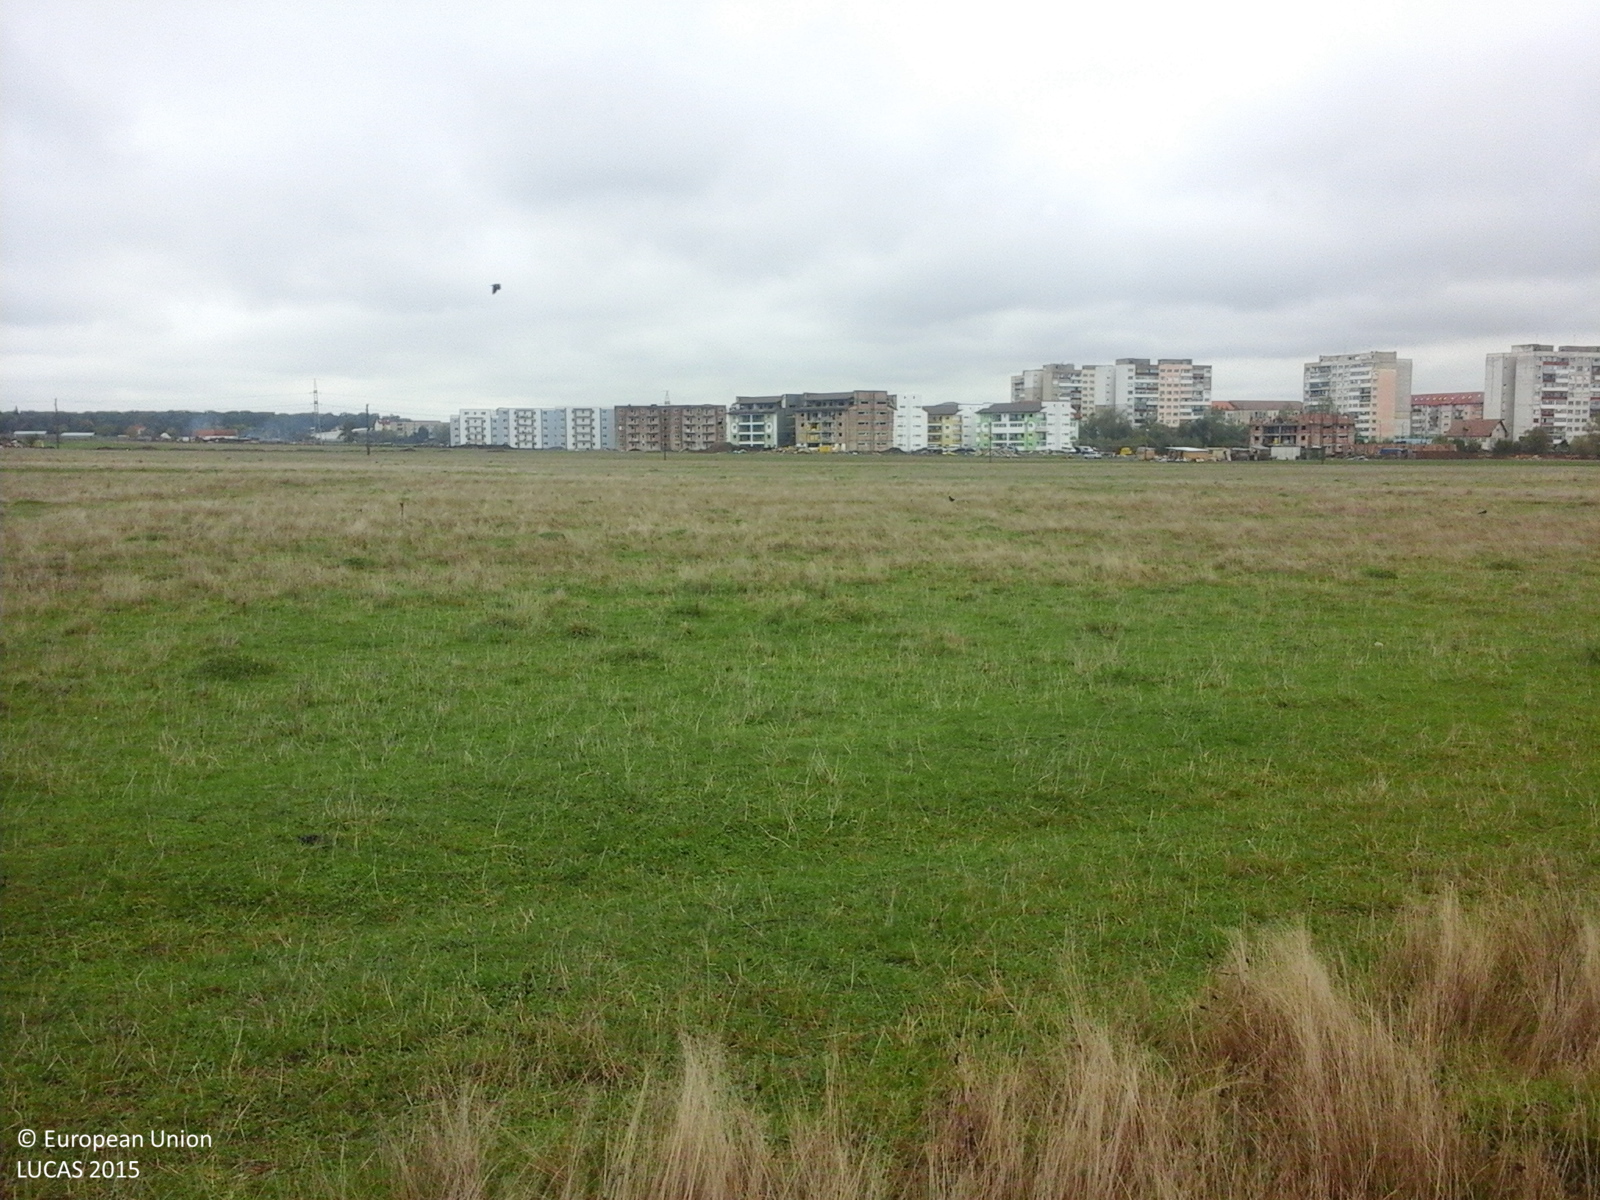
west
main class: Grassland
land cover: Grassland without tree/shrub cover
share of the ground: > 75 %
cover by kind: herbaceous plants 100 %
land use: Agriculture (excluding fallow land and kitchen gardens)
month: October
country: RO
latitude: 45.7695
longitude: 24.1555
